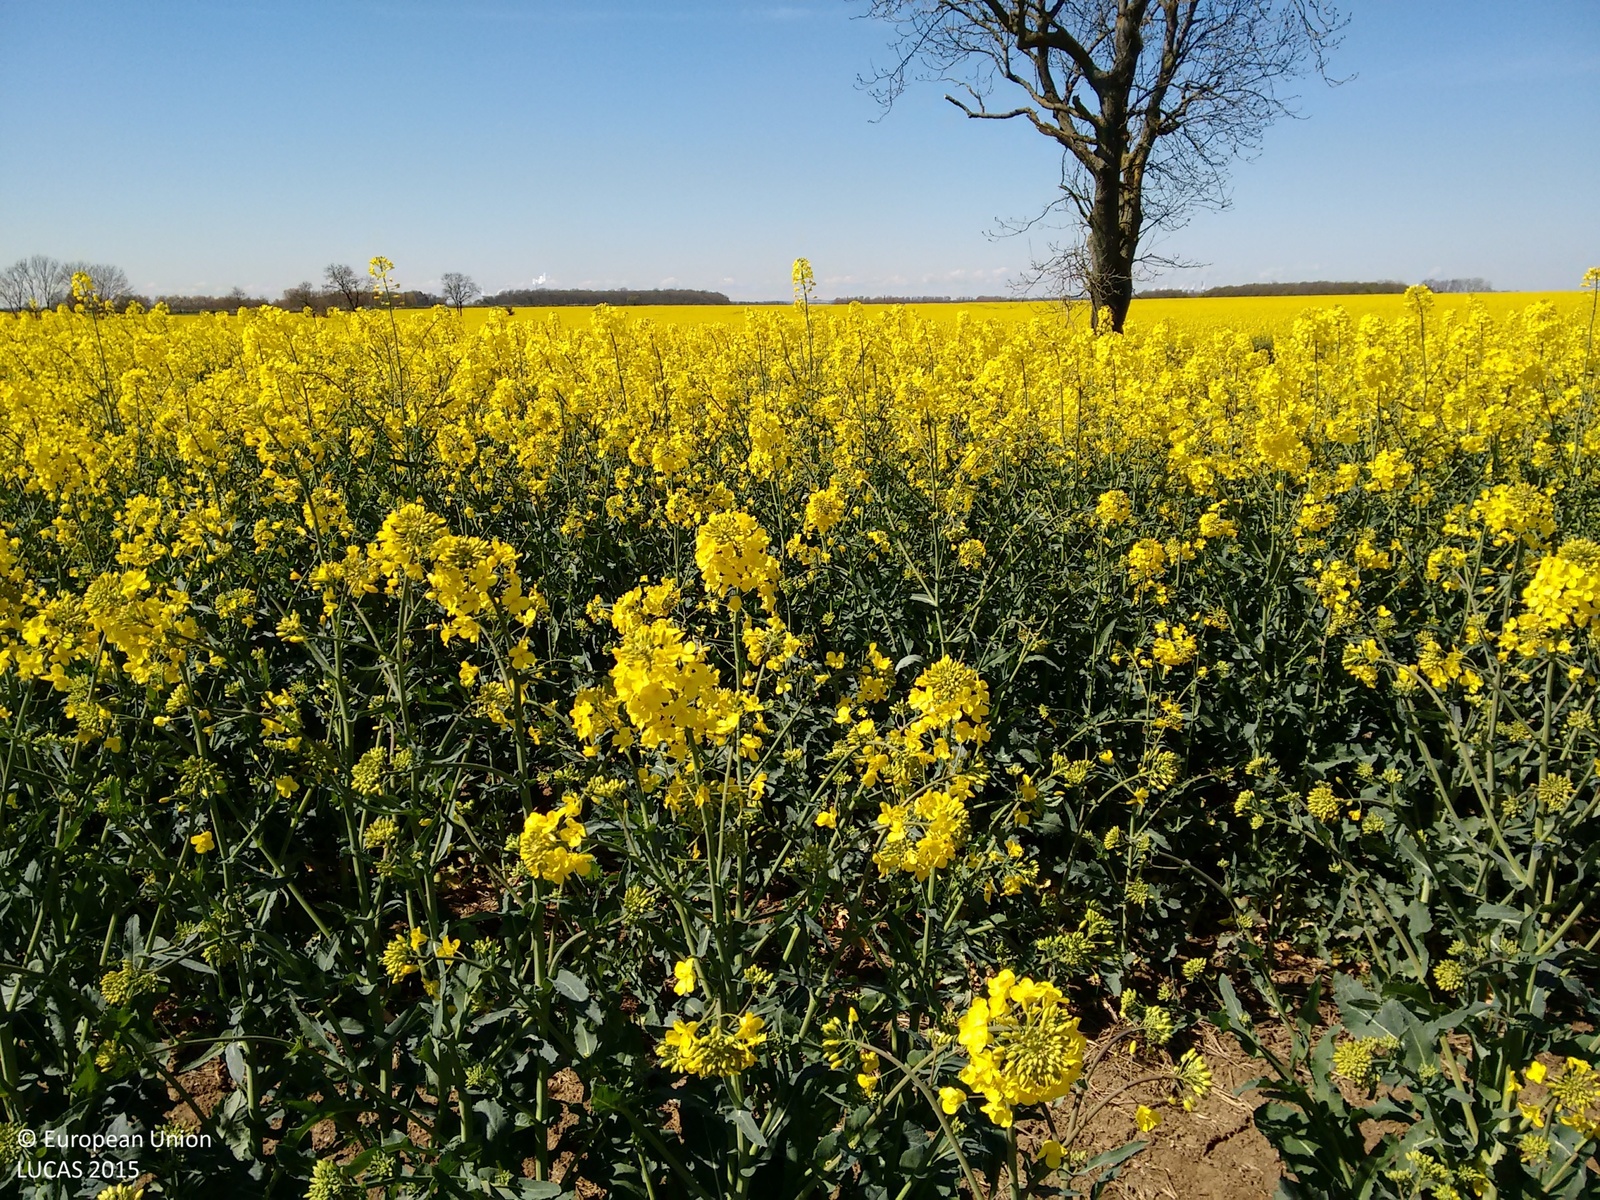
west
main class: Cropland
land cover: Rape and turnip rape
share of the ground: > 75 %
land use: Agriculture (excluding fallow land and kitchen gardens)
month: April
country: GB
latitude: 53.3525
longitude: -0.6000
